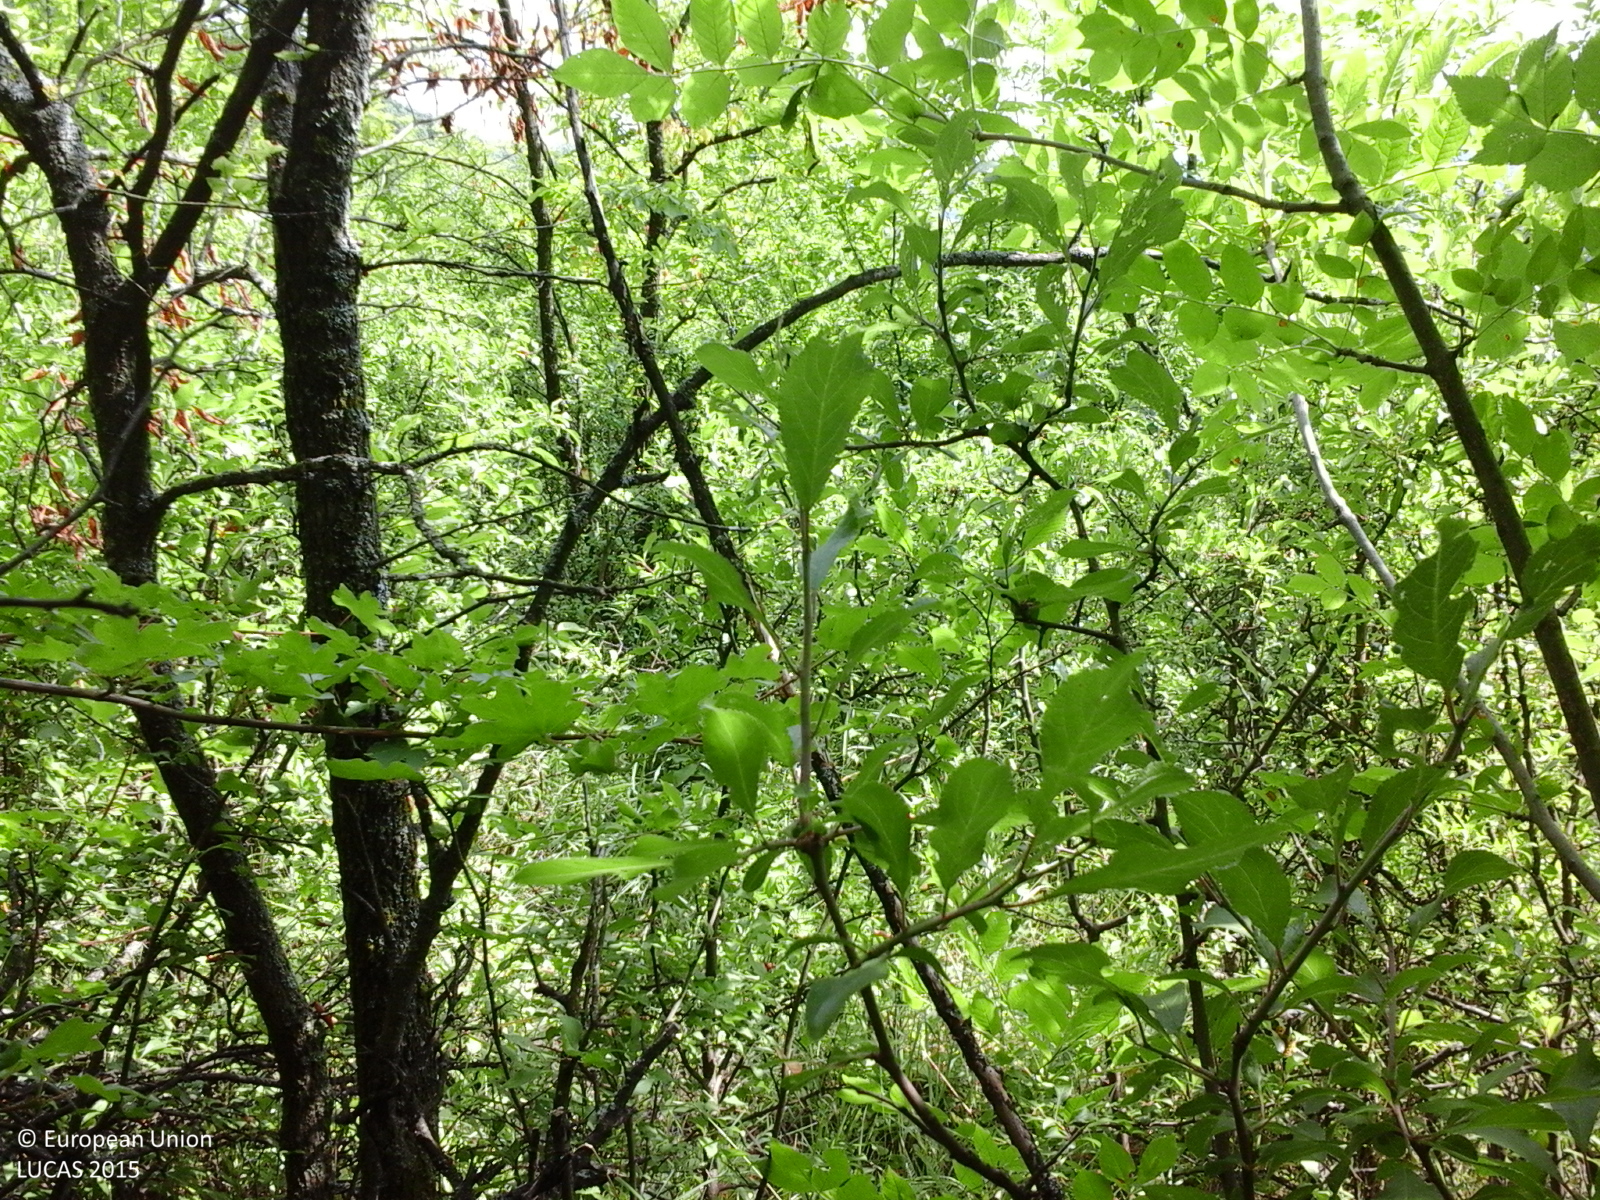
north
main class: Woodland
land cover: Broadleaved woodland
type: acidophilous oak and oak-birch forest
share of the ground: > 75 %
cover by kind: broadleaved forest trees 90 %, herbaceous plants 10 %
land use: Forestry
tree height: > 5 m
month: June
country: RO
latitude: 46.7038
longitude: 27.4674
